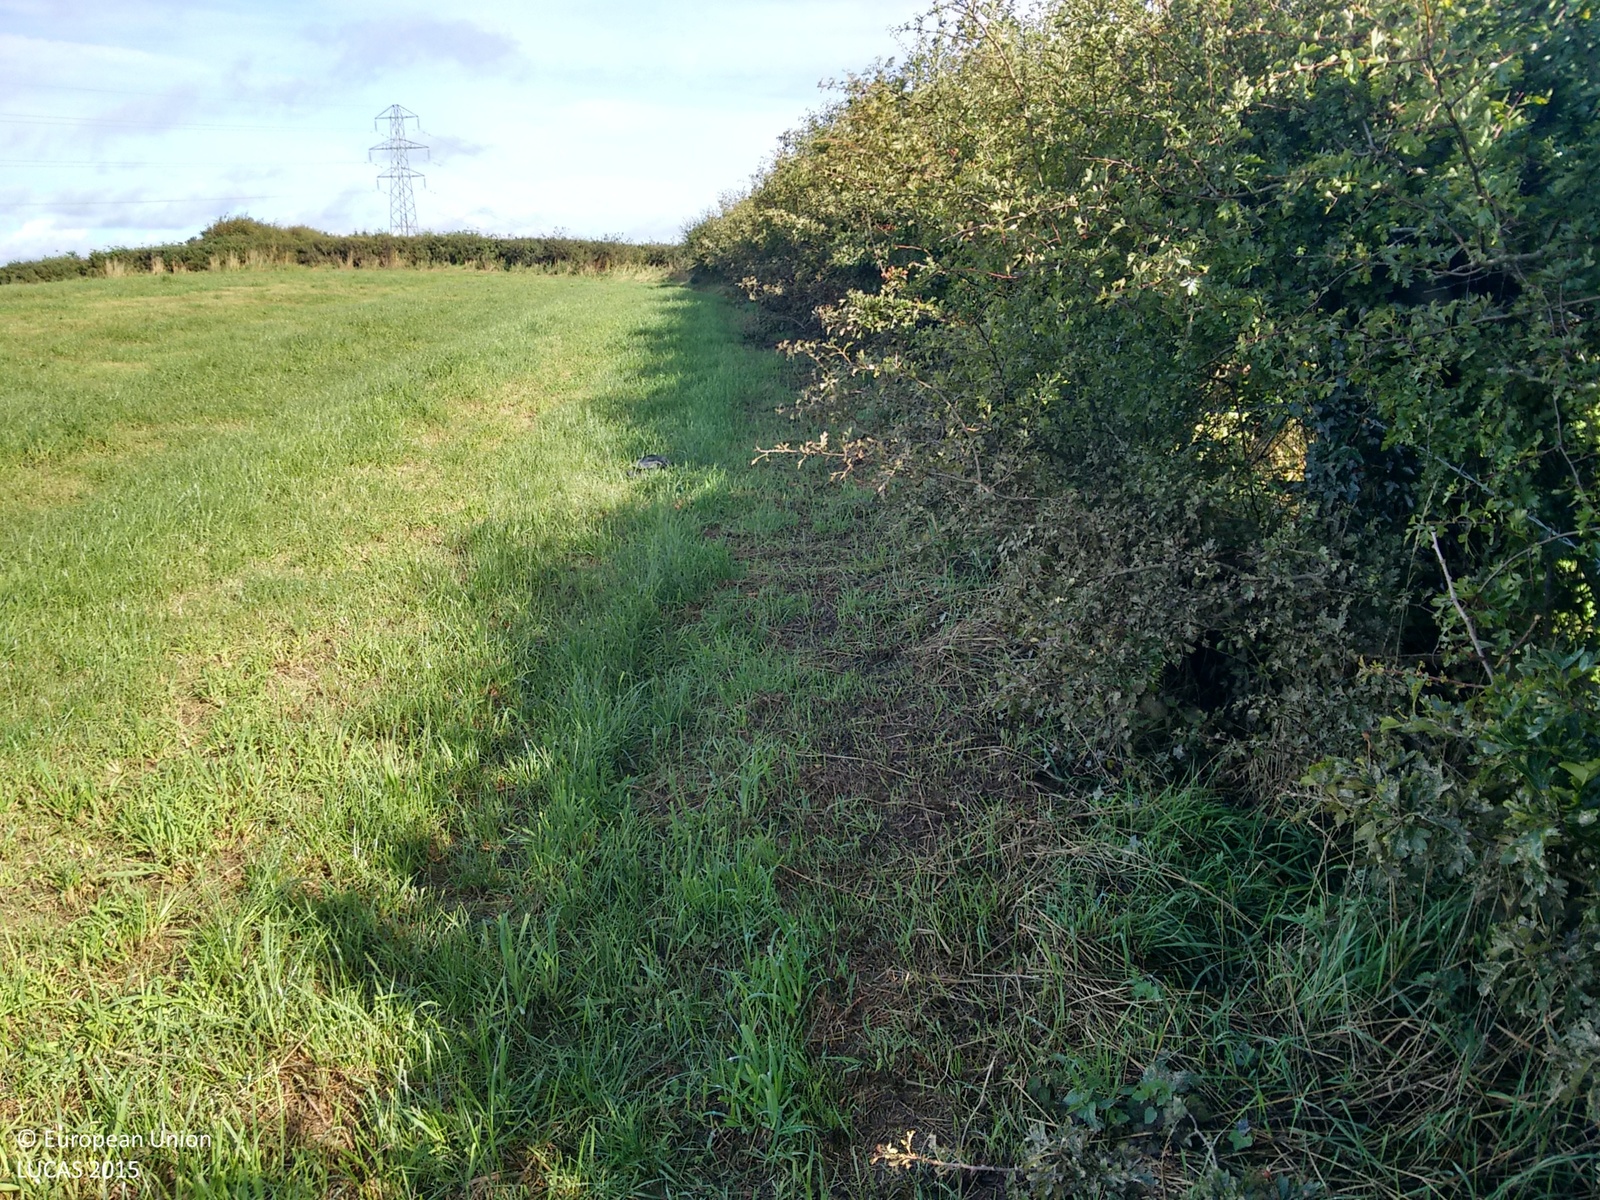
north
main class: Grassland
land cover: Grassland without tree/shrub cover
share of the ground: > 75 %
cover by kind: herbaceous plants 100 %
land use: Agriculture (excluding fallow land and kitchen gardens)
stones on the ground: < 10 %
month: August
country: GB
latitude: 54.4017
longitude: -5.8652
